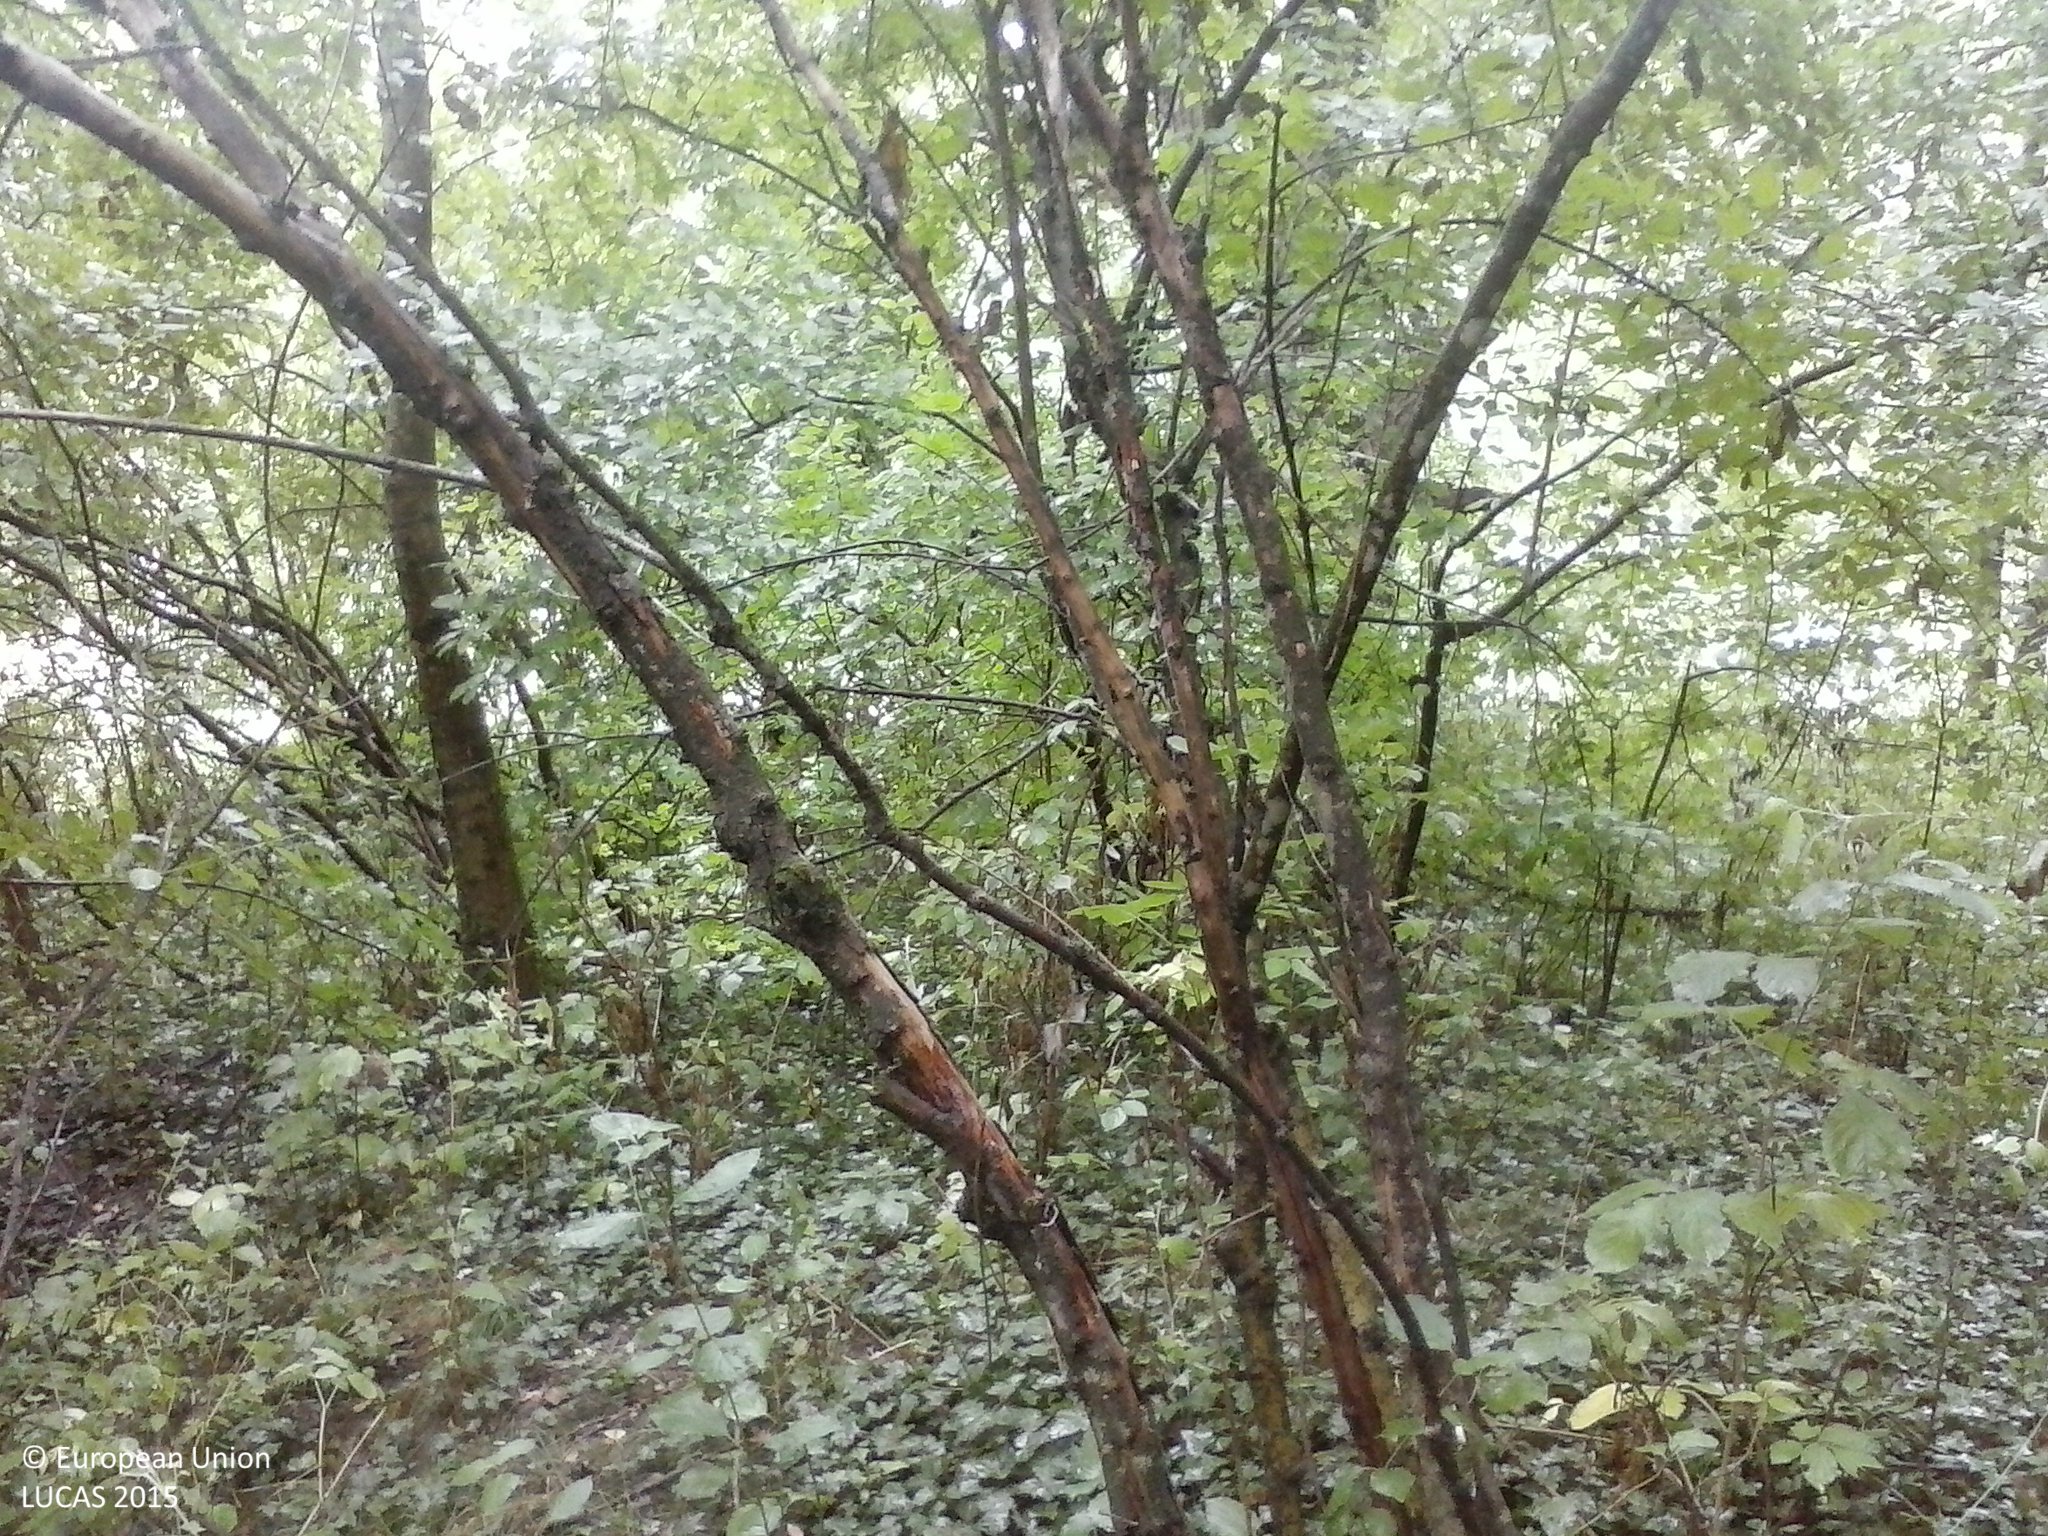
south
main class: Woodland
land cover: Broadleaved woodland
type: mesophytic deciduous forest
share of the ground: > 75 %
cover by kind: broadleaved forest trees 90 %, shrubs 5 %, herbaceous plants 5 %
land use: Semi-natural and natural areas not in use
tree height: > 5 m
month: July
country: HU
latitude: 45.9124
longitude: 17.6745
